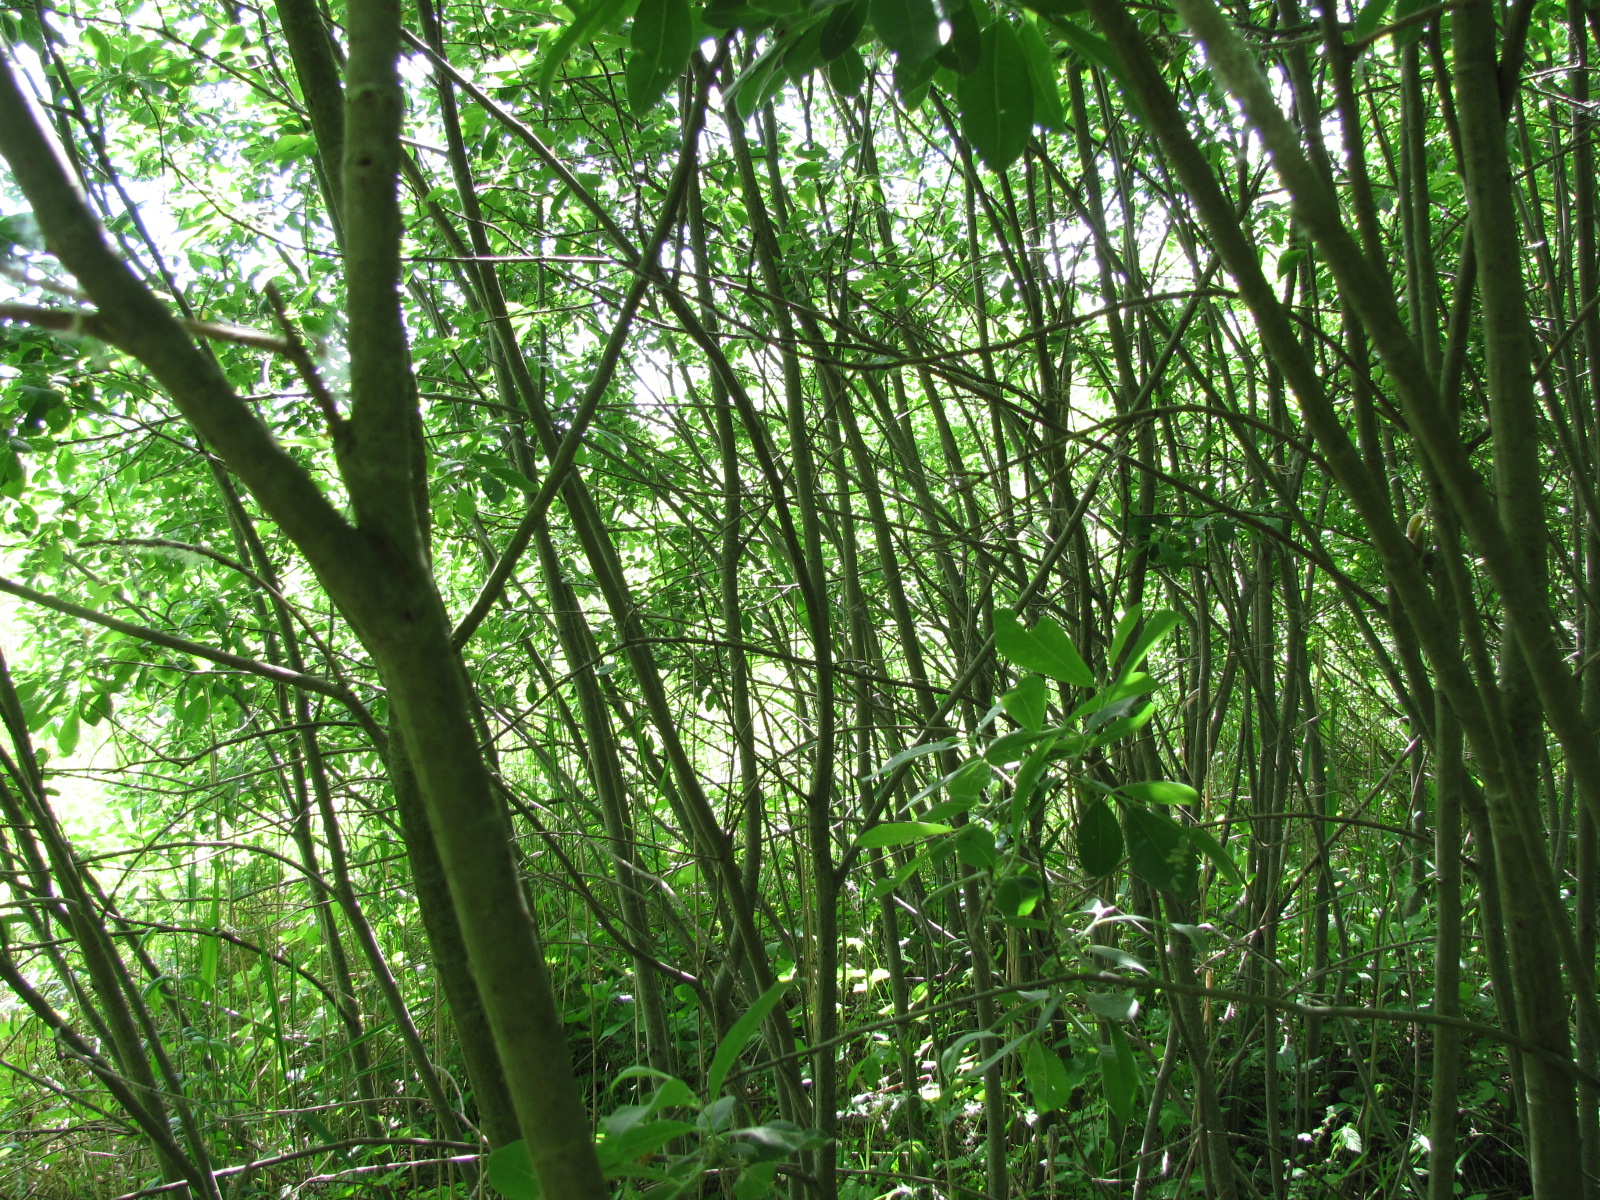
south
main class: Shrubland
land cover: Shrubland without tree cover
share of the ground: > 75 %
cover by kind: shrubs 100 %
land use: Semi-natural and natural areas not in use
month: June
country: LV
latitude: 56.2788
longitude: 24.1243
